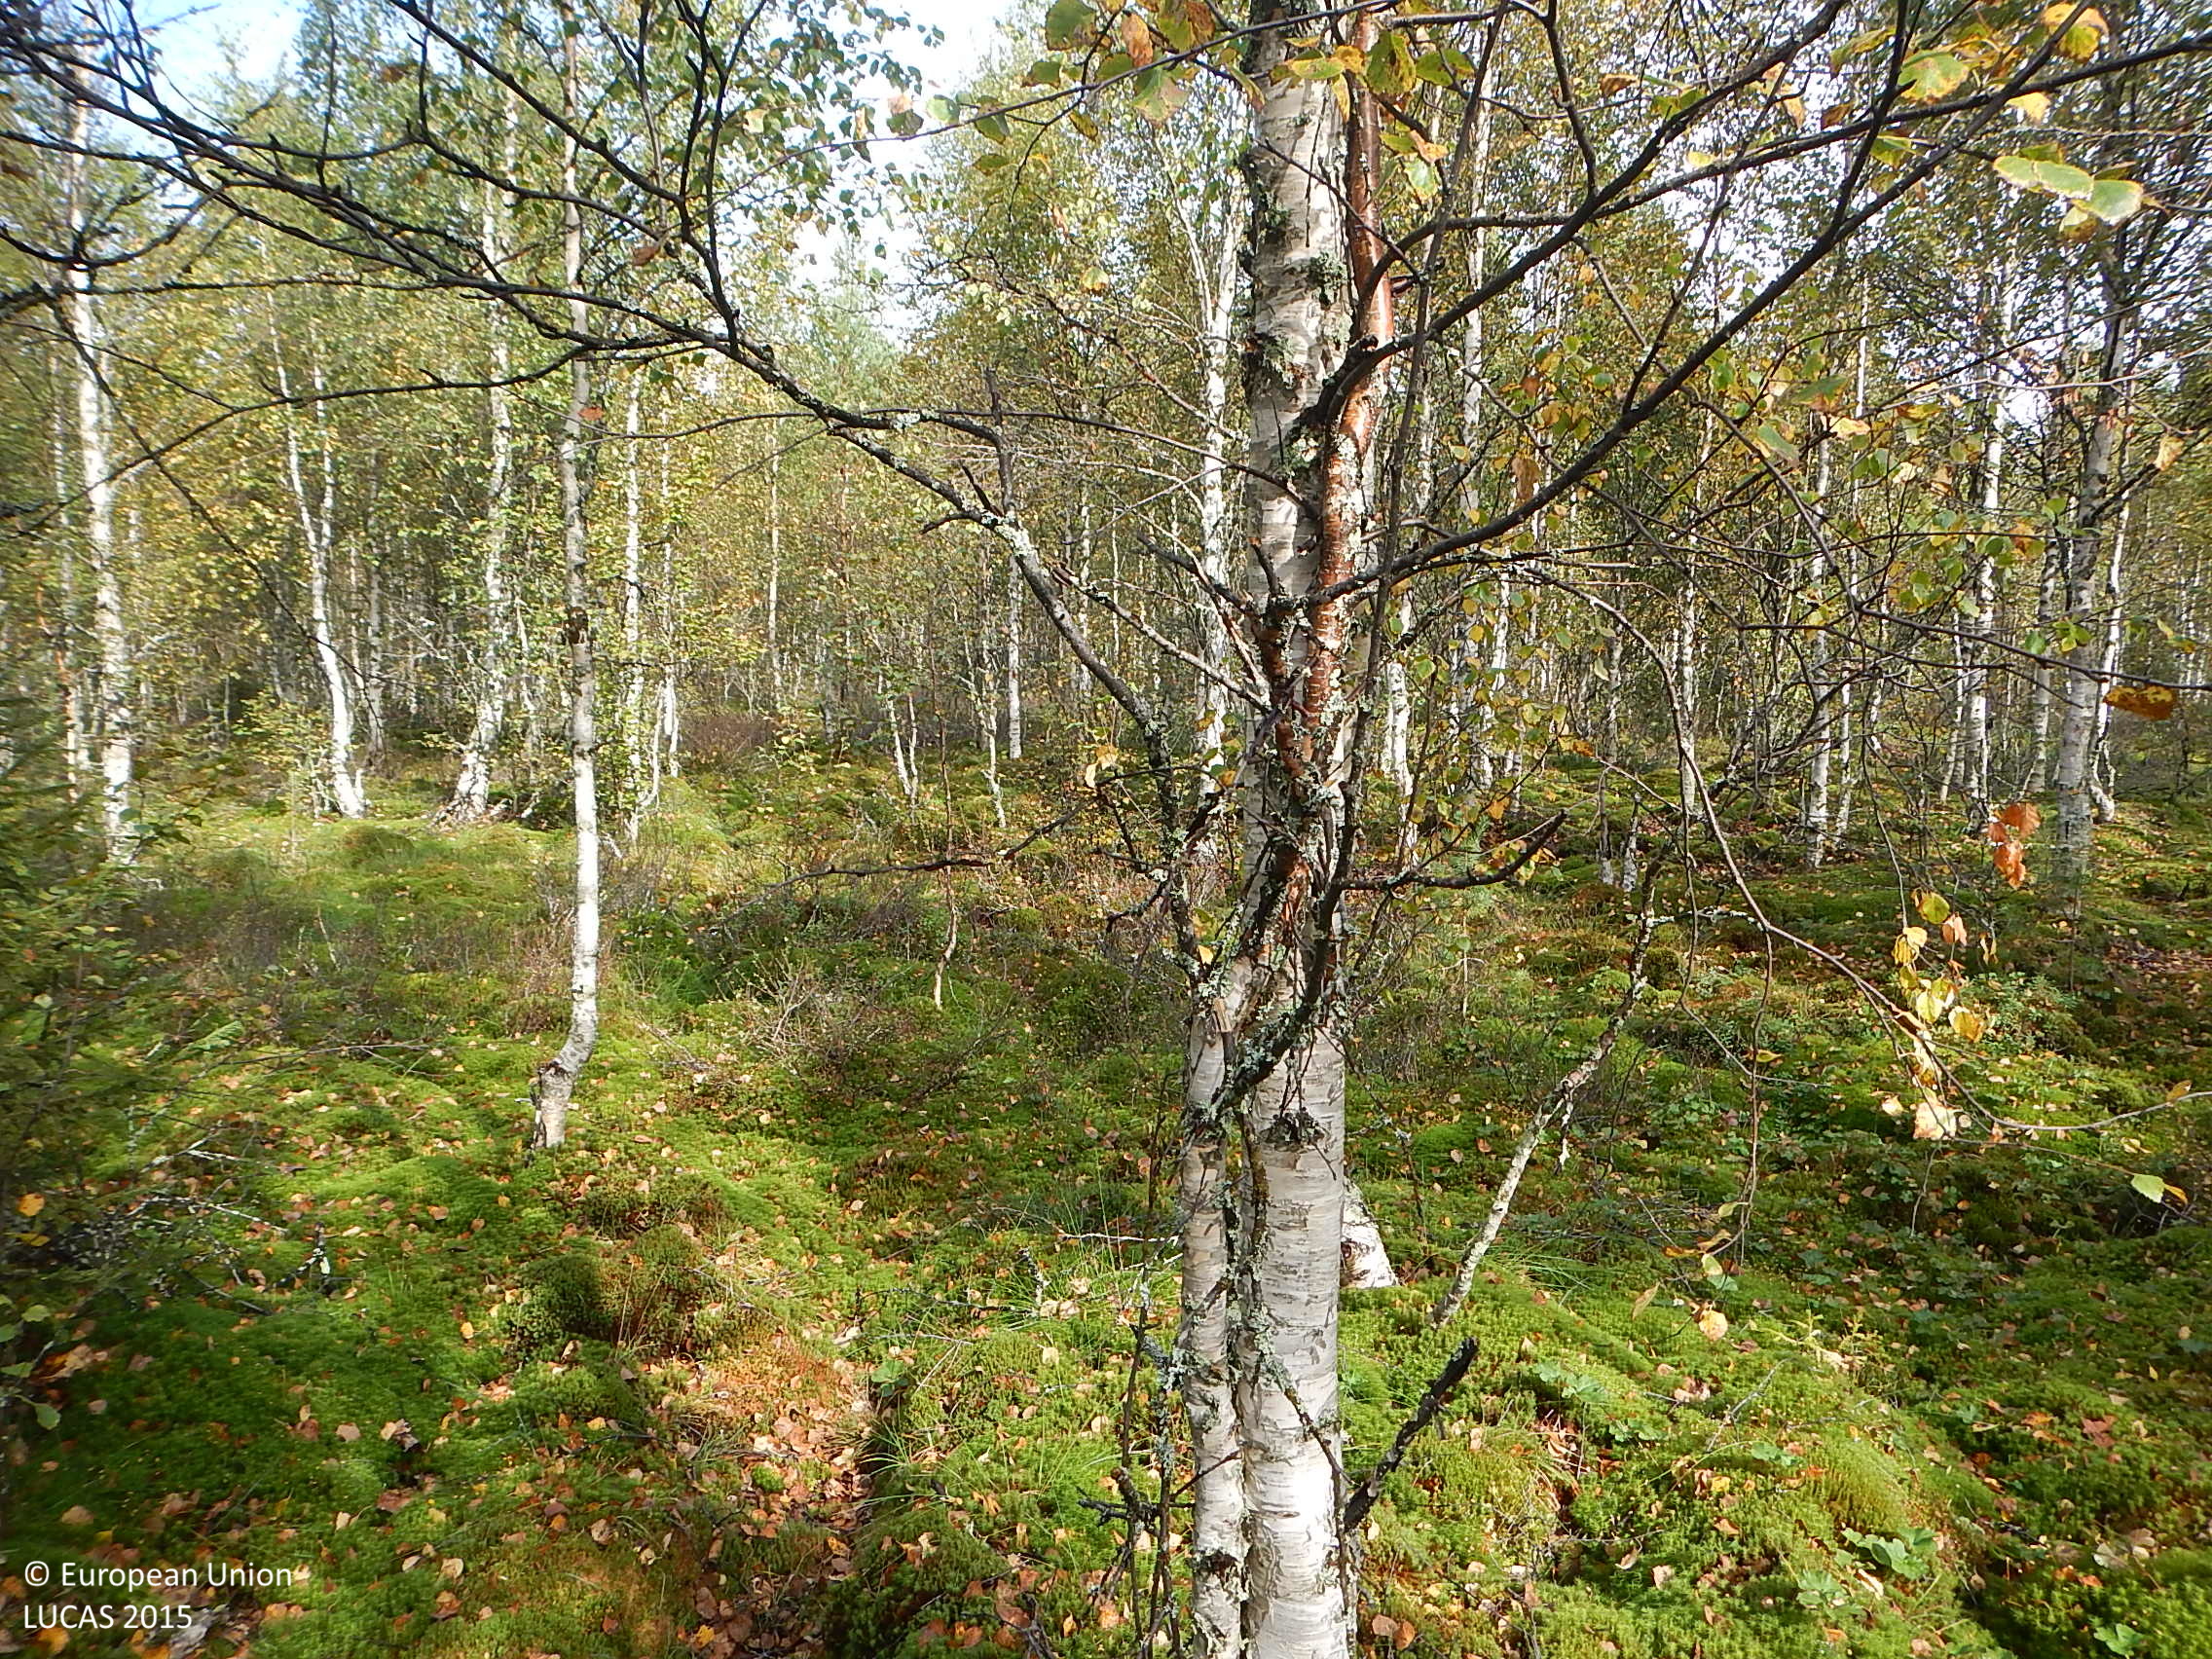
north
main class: Woodland
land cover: Broadleaved woodland
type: mire and swamp forests
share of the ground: > 75 %
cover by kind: broadleaved forest trees 75 %, lichens and mosses 20 %, herbaceous plants 5 %
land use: Forestry
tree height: > 5 m
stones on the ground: < 10 %
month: August
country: FI
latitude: 65.7415
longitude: 26.9719
